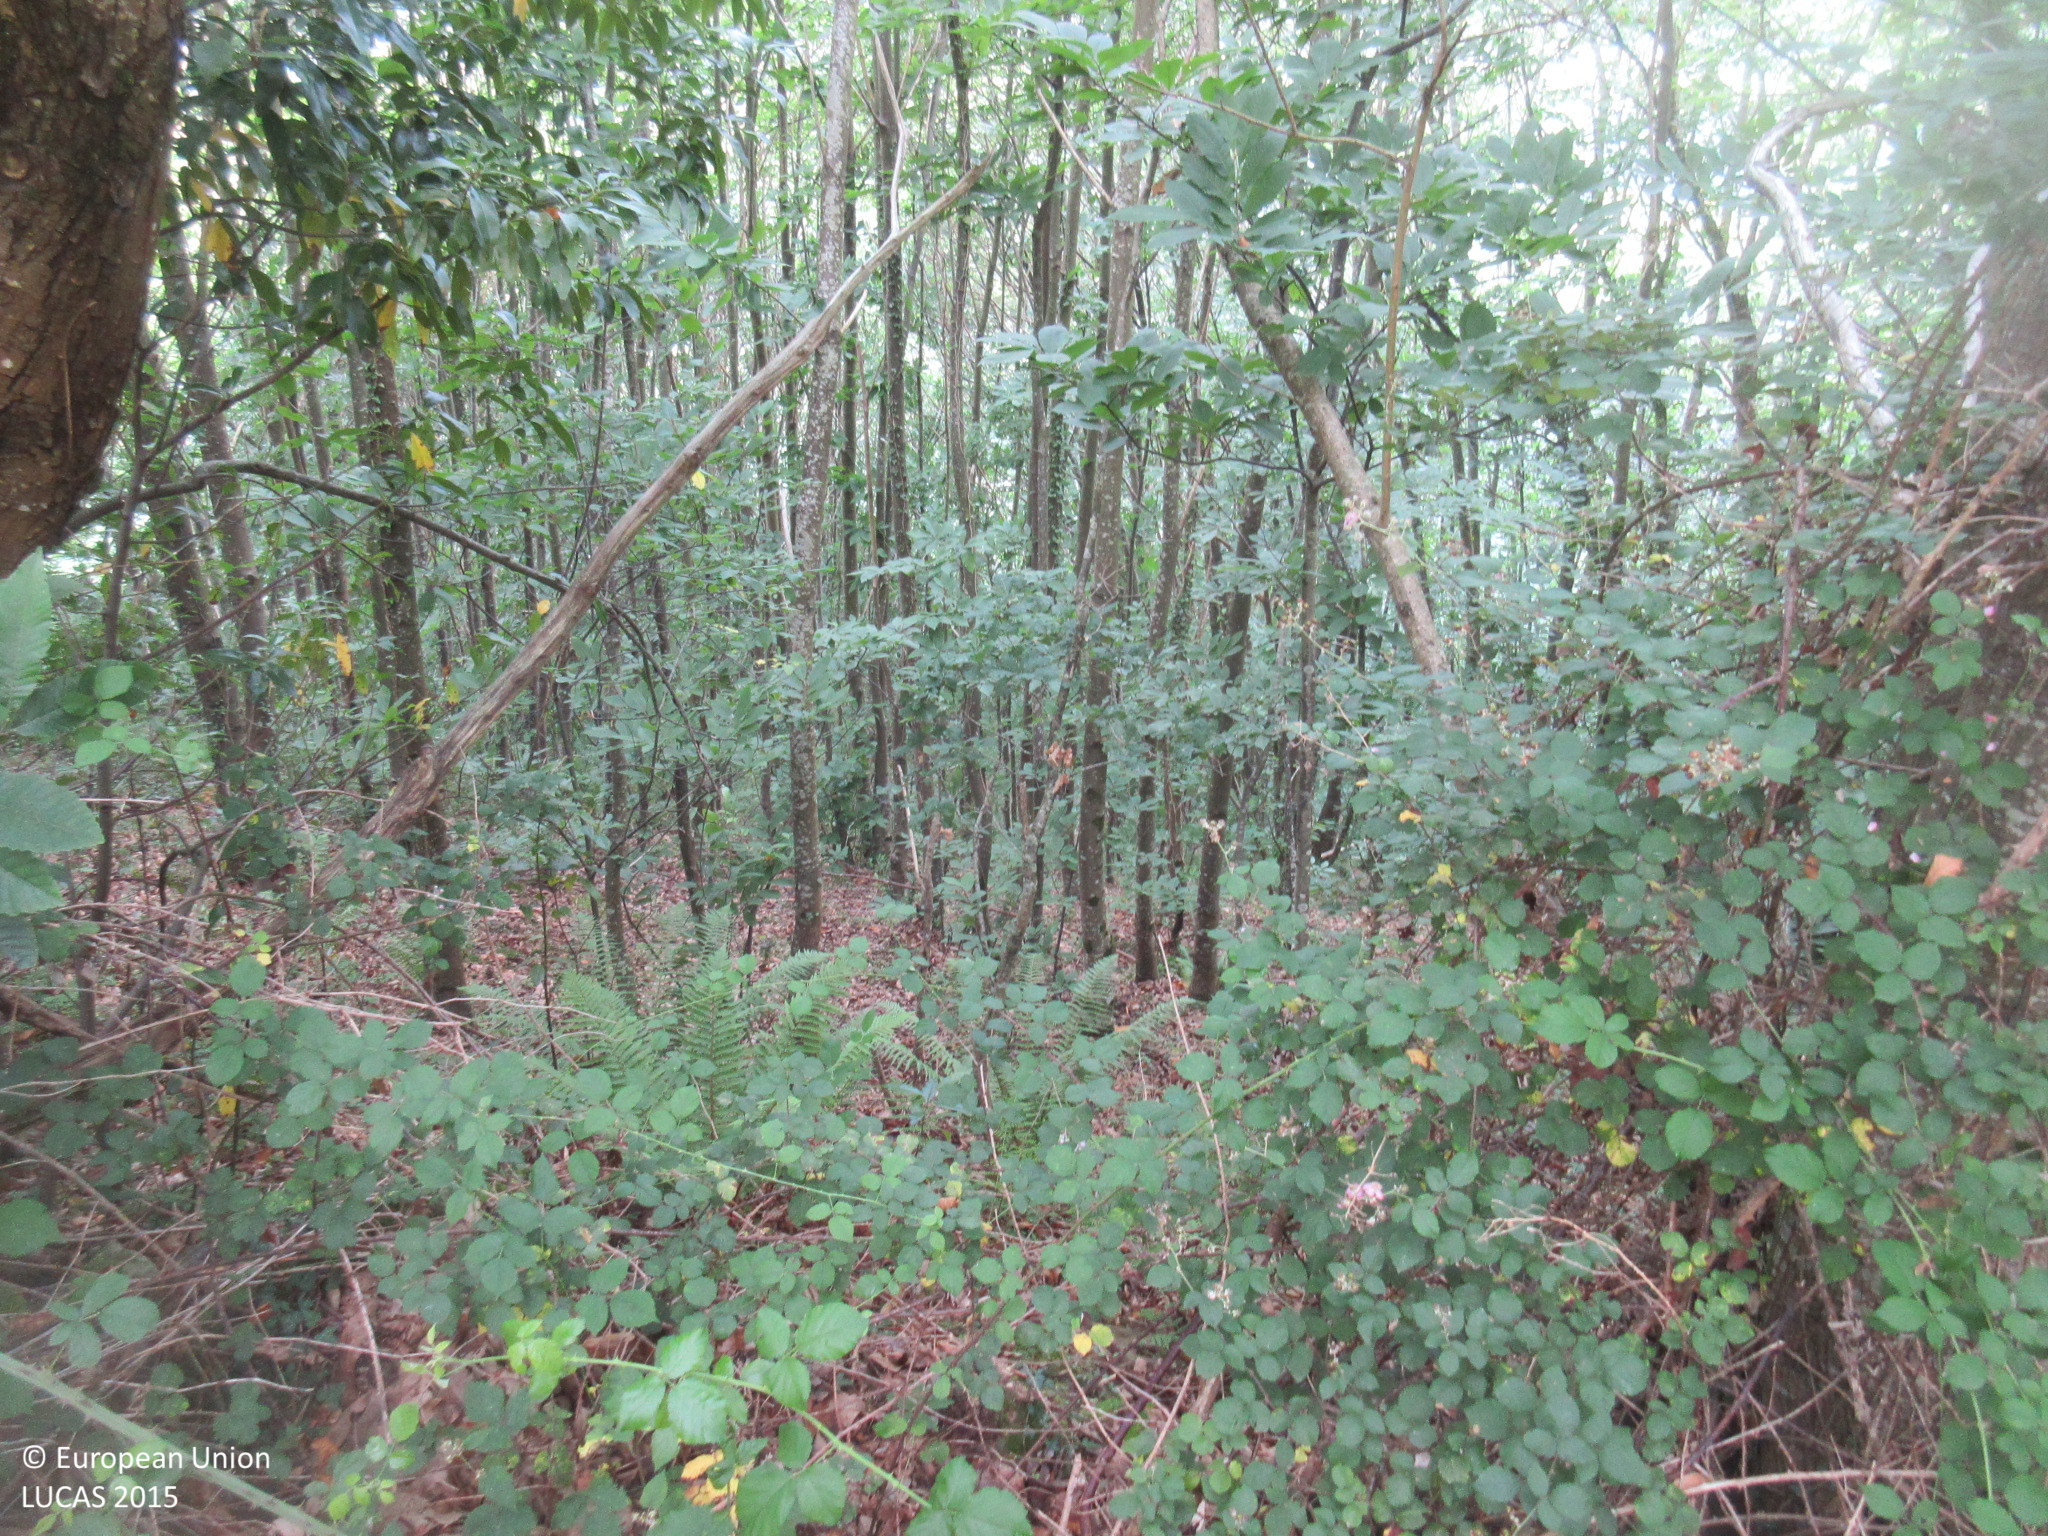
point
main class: Woodland
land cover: Broadleaved woodland
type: thermophilous deciduous forest
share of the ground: > 75 %
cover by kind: broadleaved forest trees 100 %
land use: Forestry
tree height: > 5 m
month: July
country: ES
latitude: 43.4689
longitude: -6.3303
